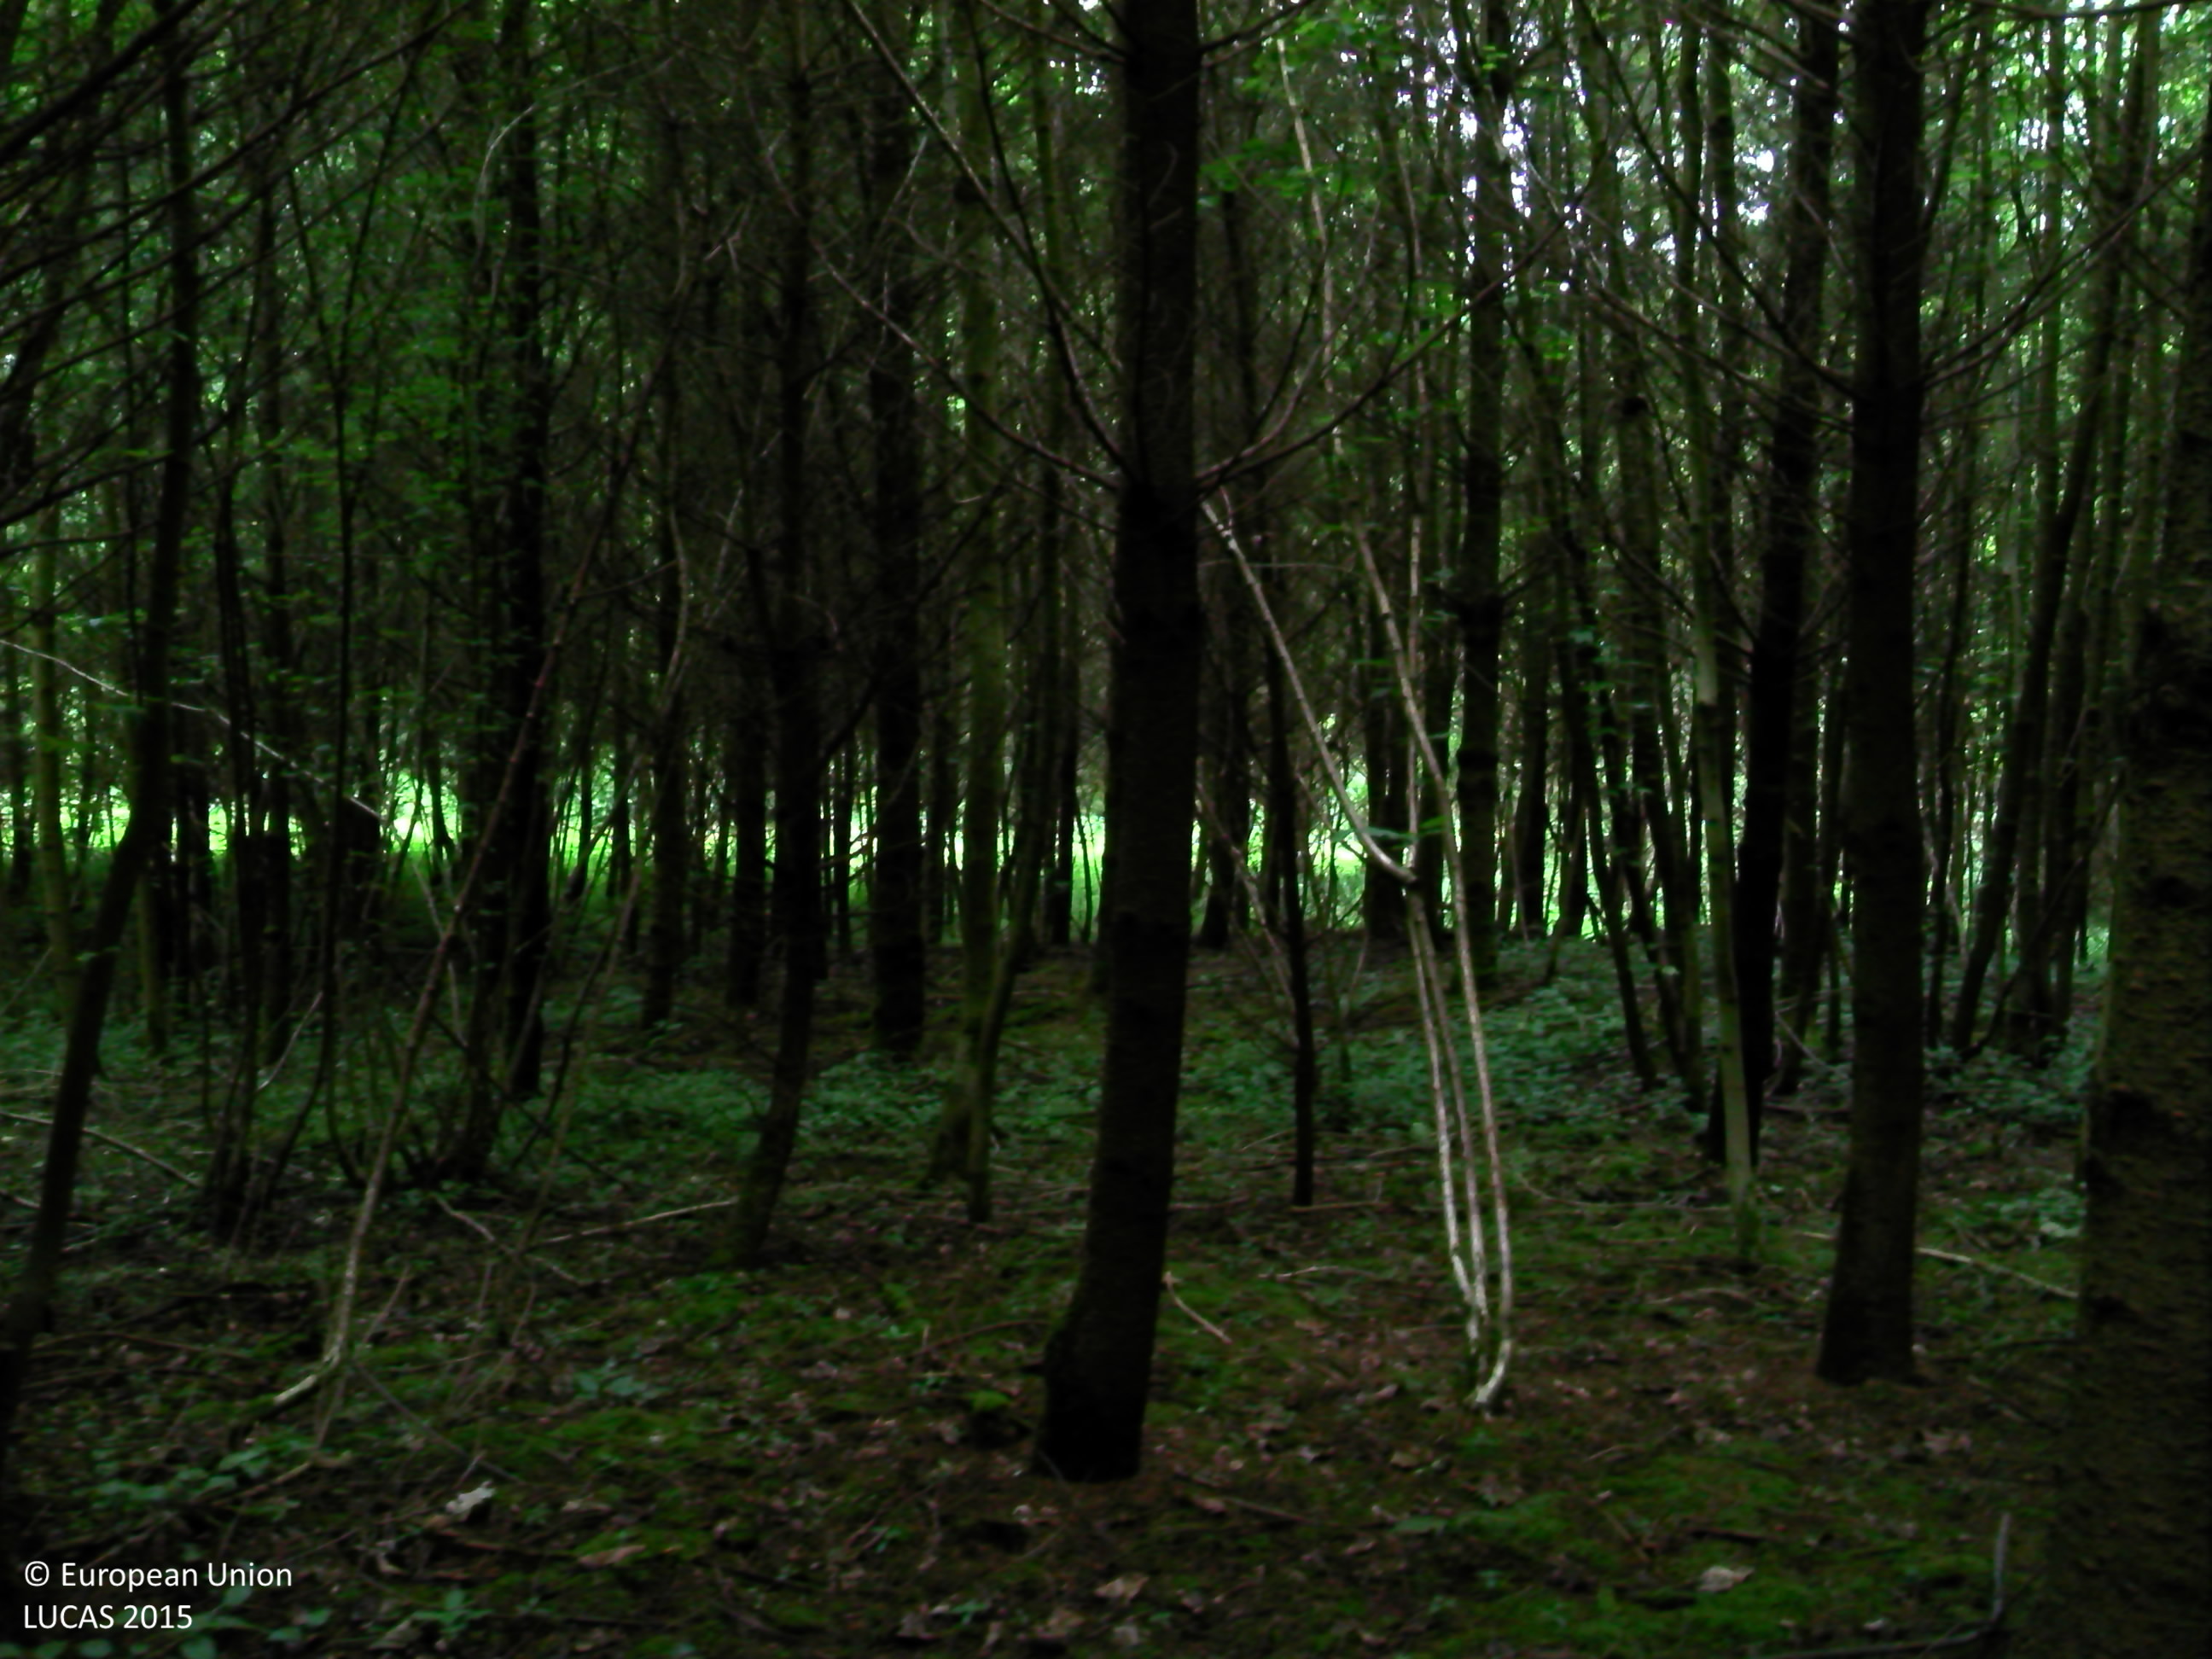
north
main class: Woodland
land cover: Spruce dominated coniferous woodland
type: exotic forest
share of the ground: > 75 %
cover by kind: coniferous forest trees 80 %, broadleaved forest trees 10 %, lichens and mosses 10 %
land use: Forestry
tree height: > 5 m
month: June
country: BE
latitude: 50.4906
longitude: 5.4735
